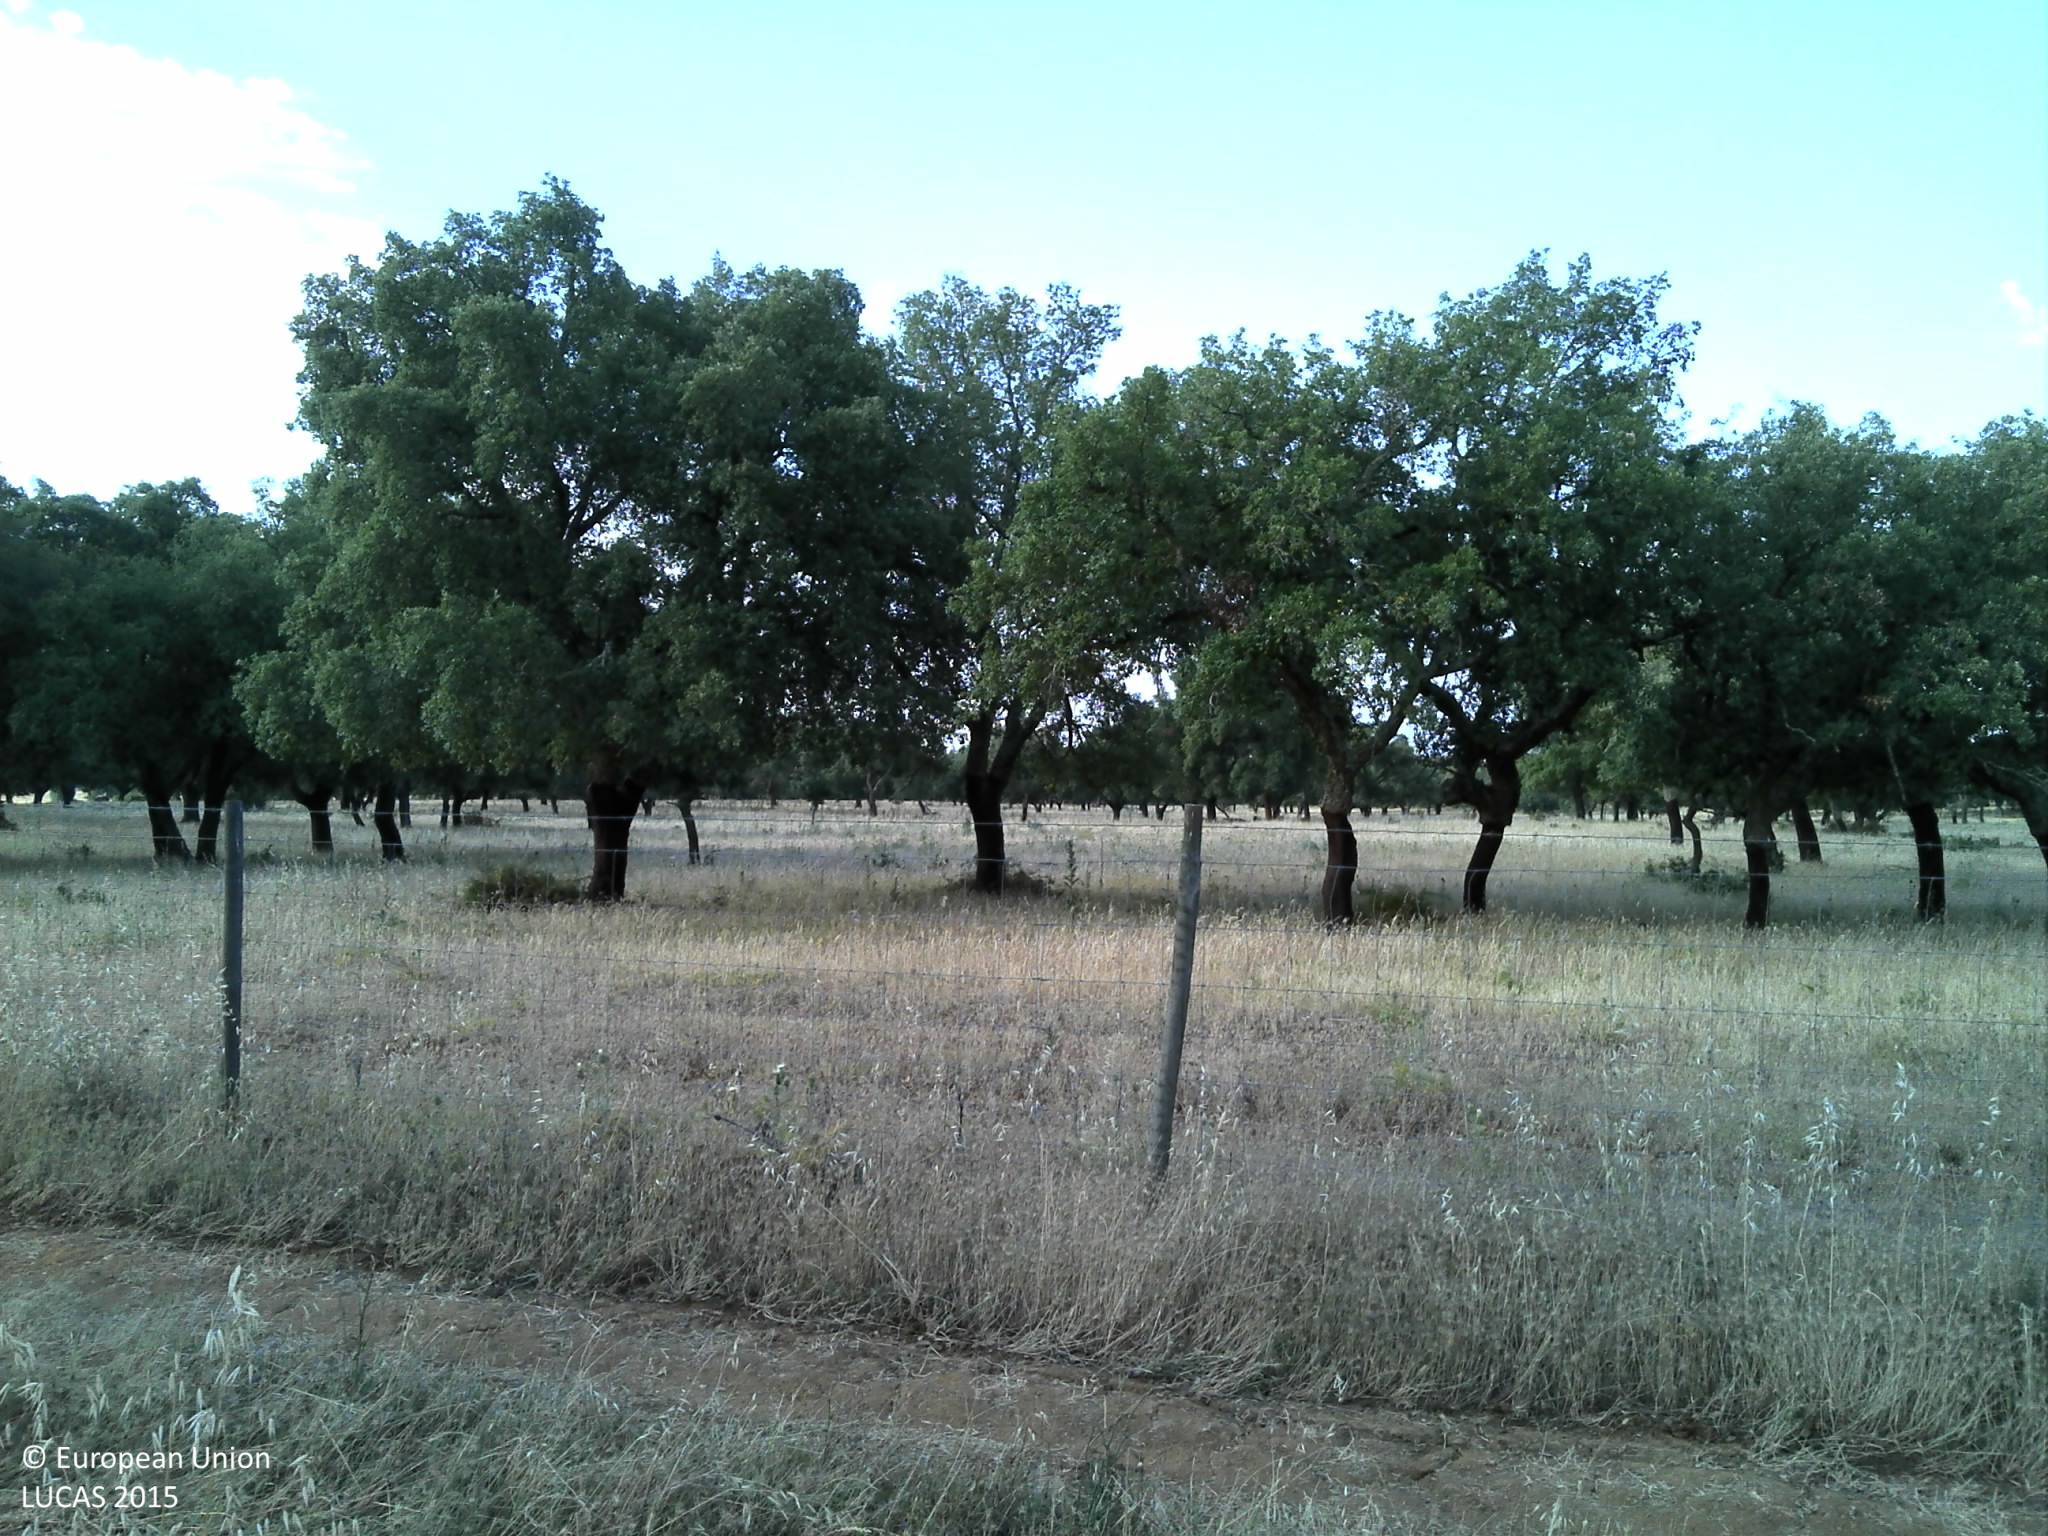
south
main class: Woodland
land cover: Broadleaved woodland
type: broadleaved evergreen forest
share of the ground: 25 - 50 %
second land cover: Oats
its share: > 75 %
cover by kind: herbaceous plants 60 %, broadleaved forest trees 30 %, unconsolidated bare surface 10 %
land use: Forestry
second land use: Agriculture (excluding fallow land and kitchen gardens)
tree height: > 5 m
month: May
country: PT
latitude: 38.9433
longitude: -7.7764
